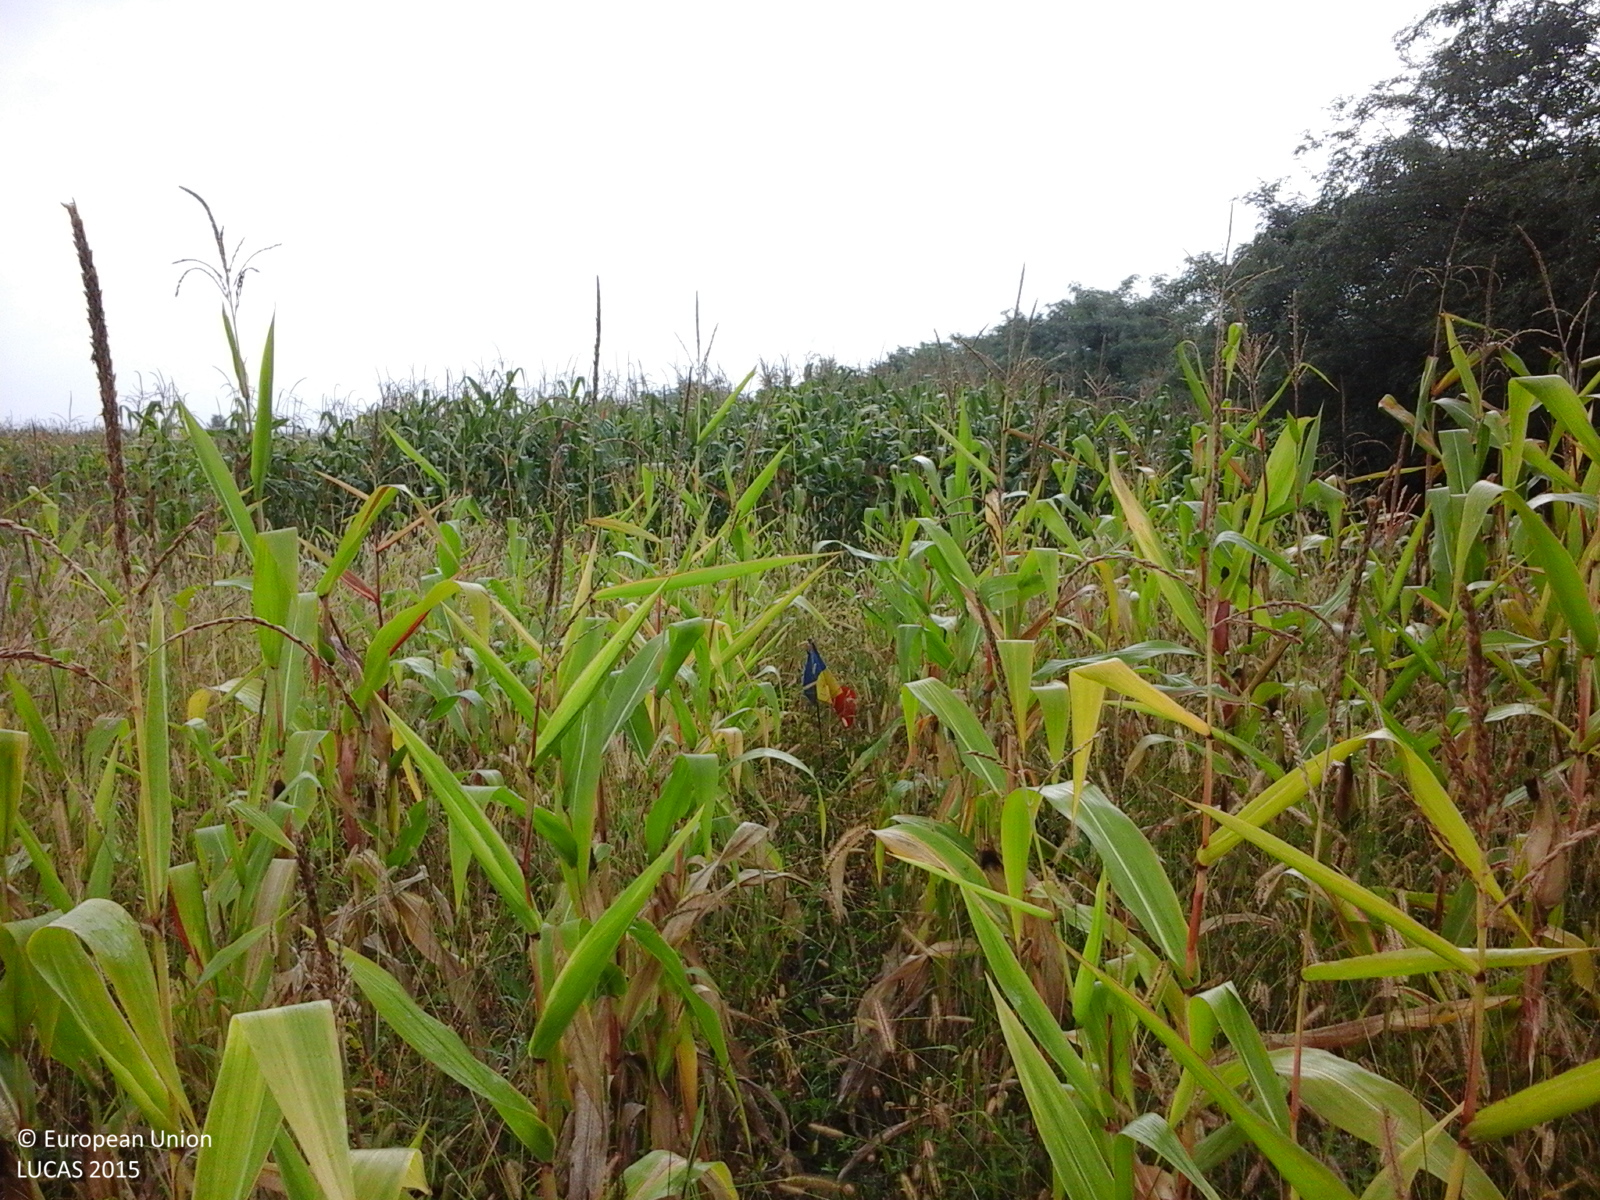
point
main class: Cropland
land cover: Maize
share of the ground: > 75 %
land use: Agriculture (excluding fallow land and kitchen gardens)
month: September
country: RO
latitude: 46.9950
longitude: 22.5340
